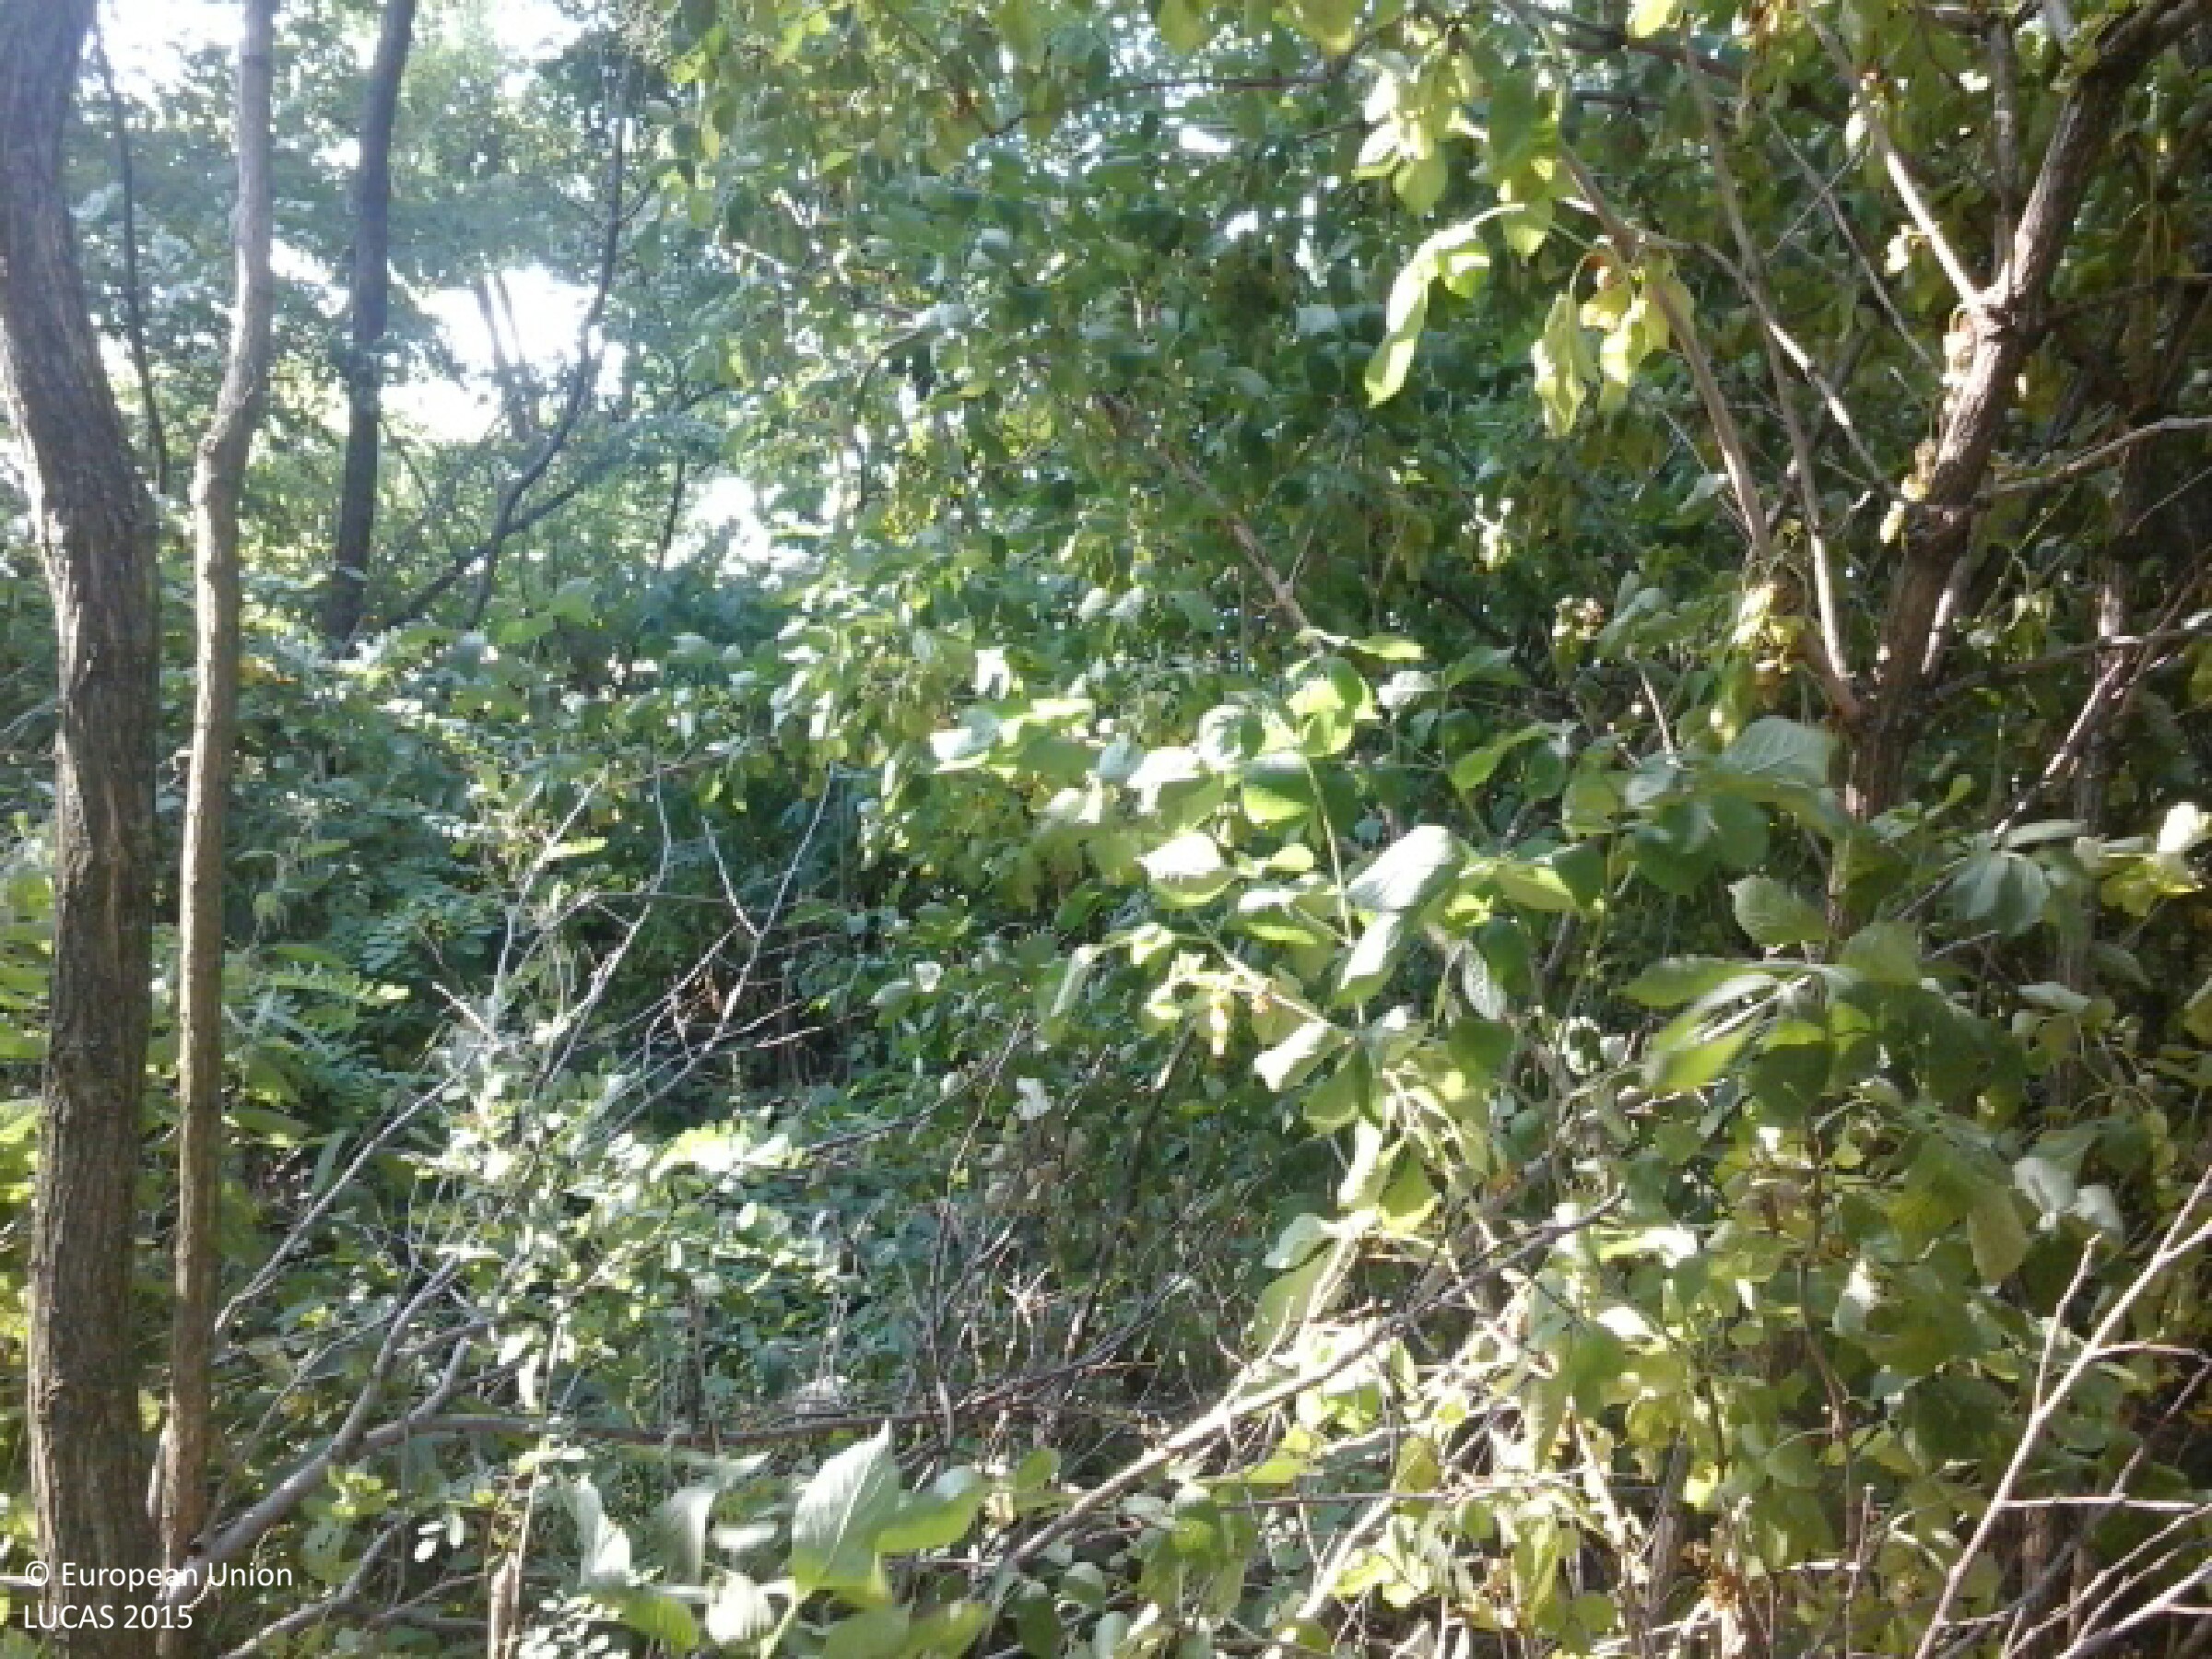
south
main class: Woodland
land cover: Broadleaved woodland
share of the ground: > 75 %
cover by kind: broadleaved forest trees 95 %, shrubs 5 %
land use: Forestry
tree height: < 5 m
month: July
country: HU
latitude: 48.2098
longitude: 21.0618
